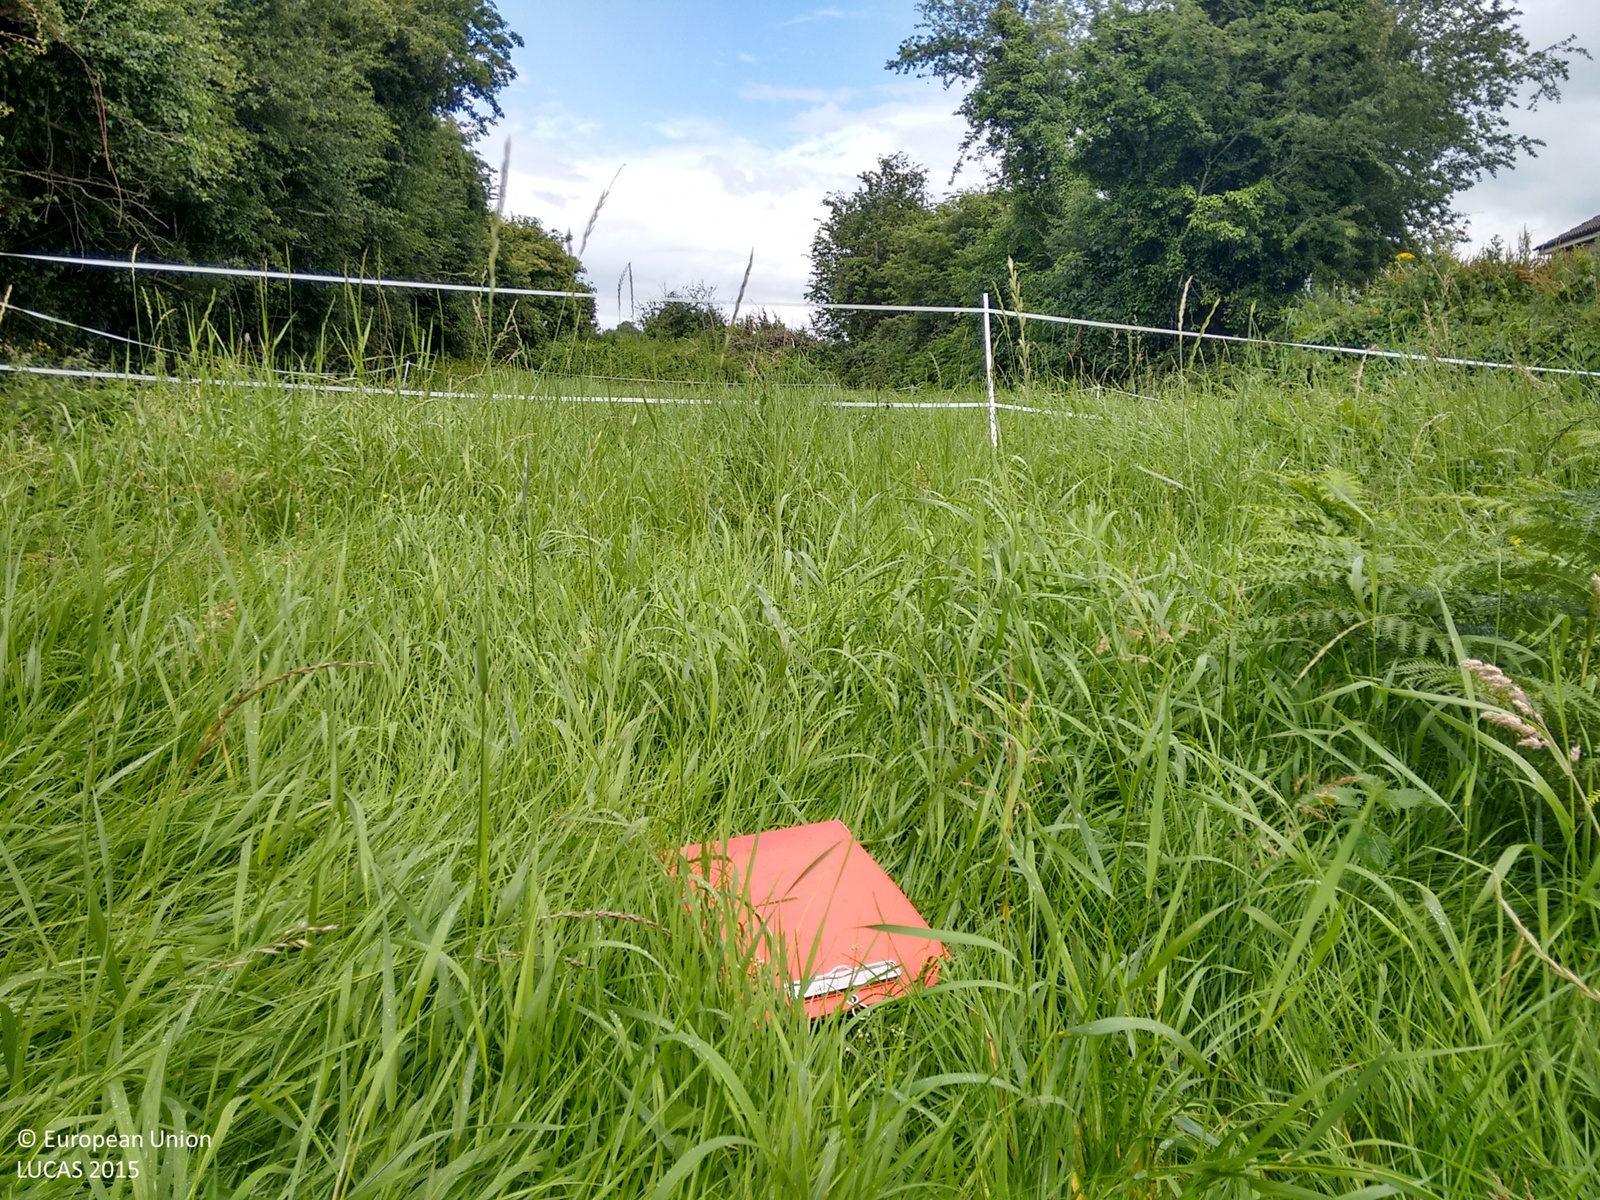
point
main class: Grassland
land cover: Grassland without tree/shrub cover
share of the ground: > 75 %
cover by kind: herbaceous plants 100 %
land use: Residential
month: July
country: IE
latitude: 52.7976
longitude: -6.4554
